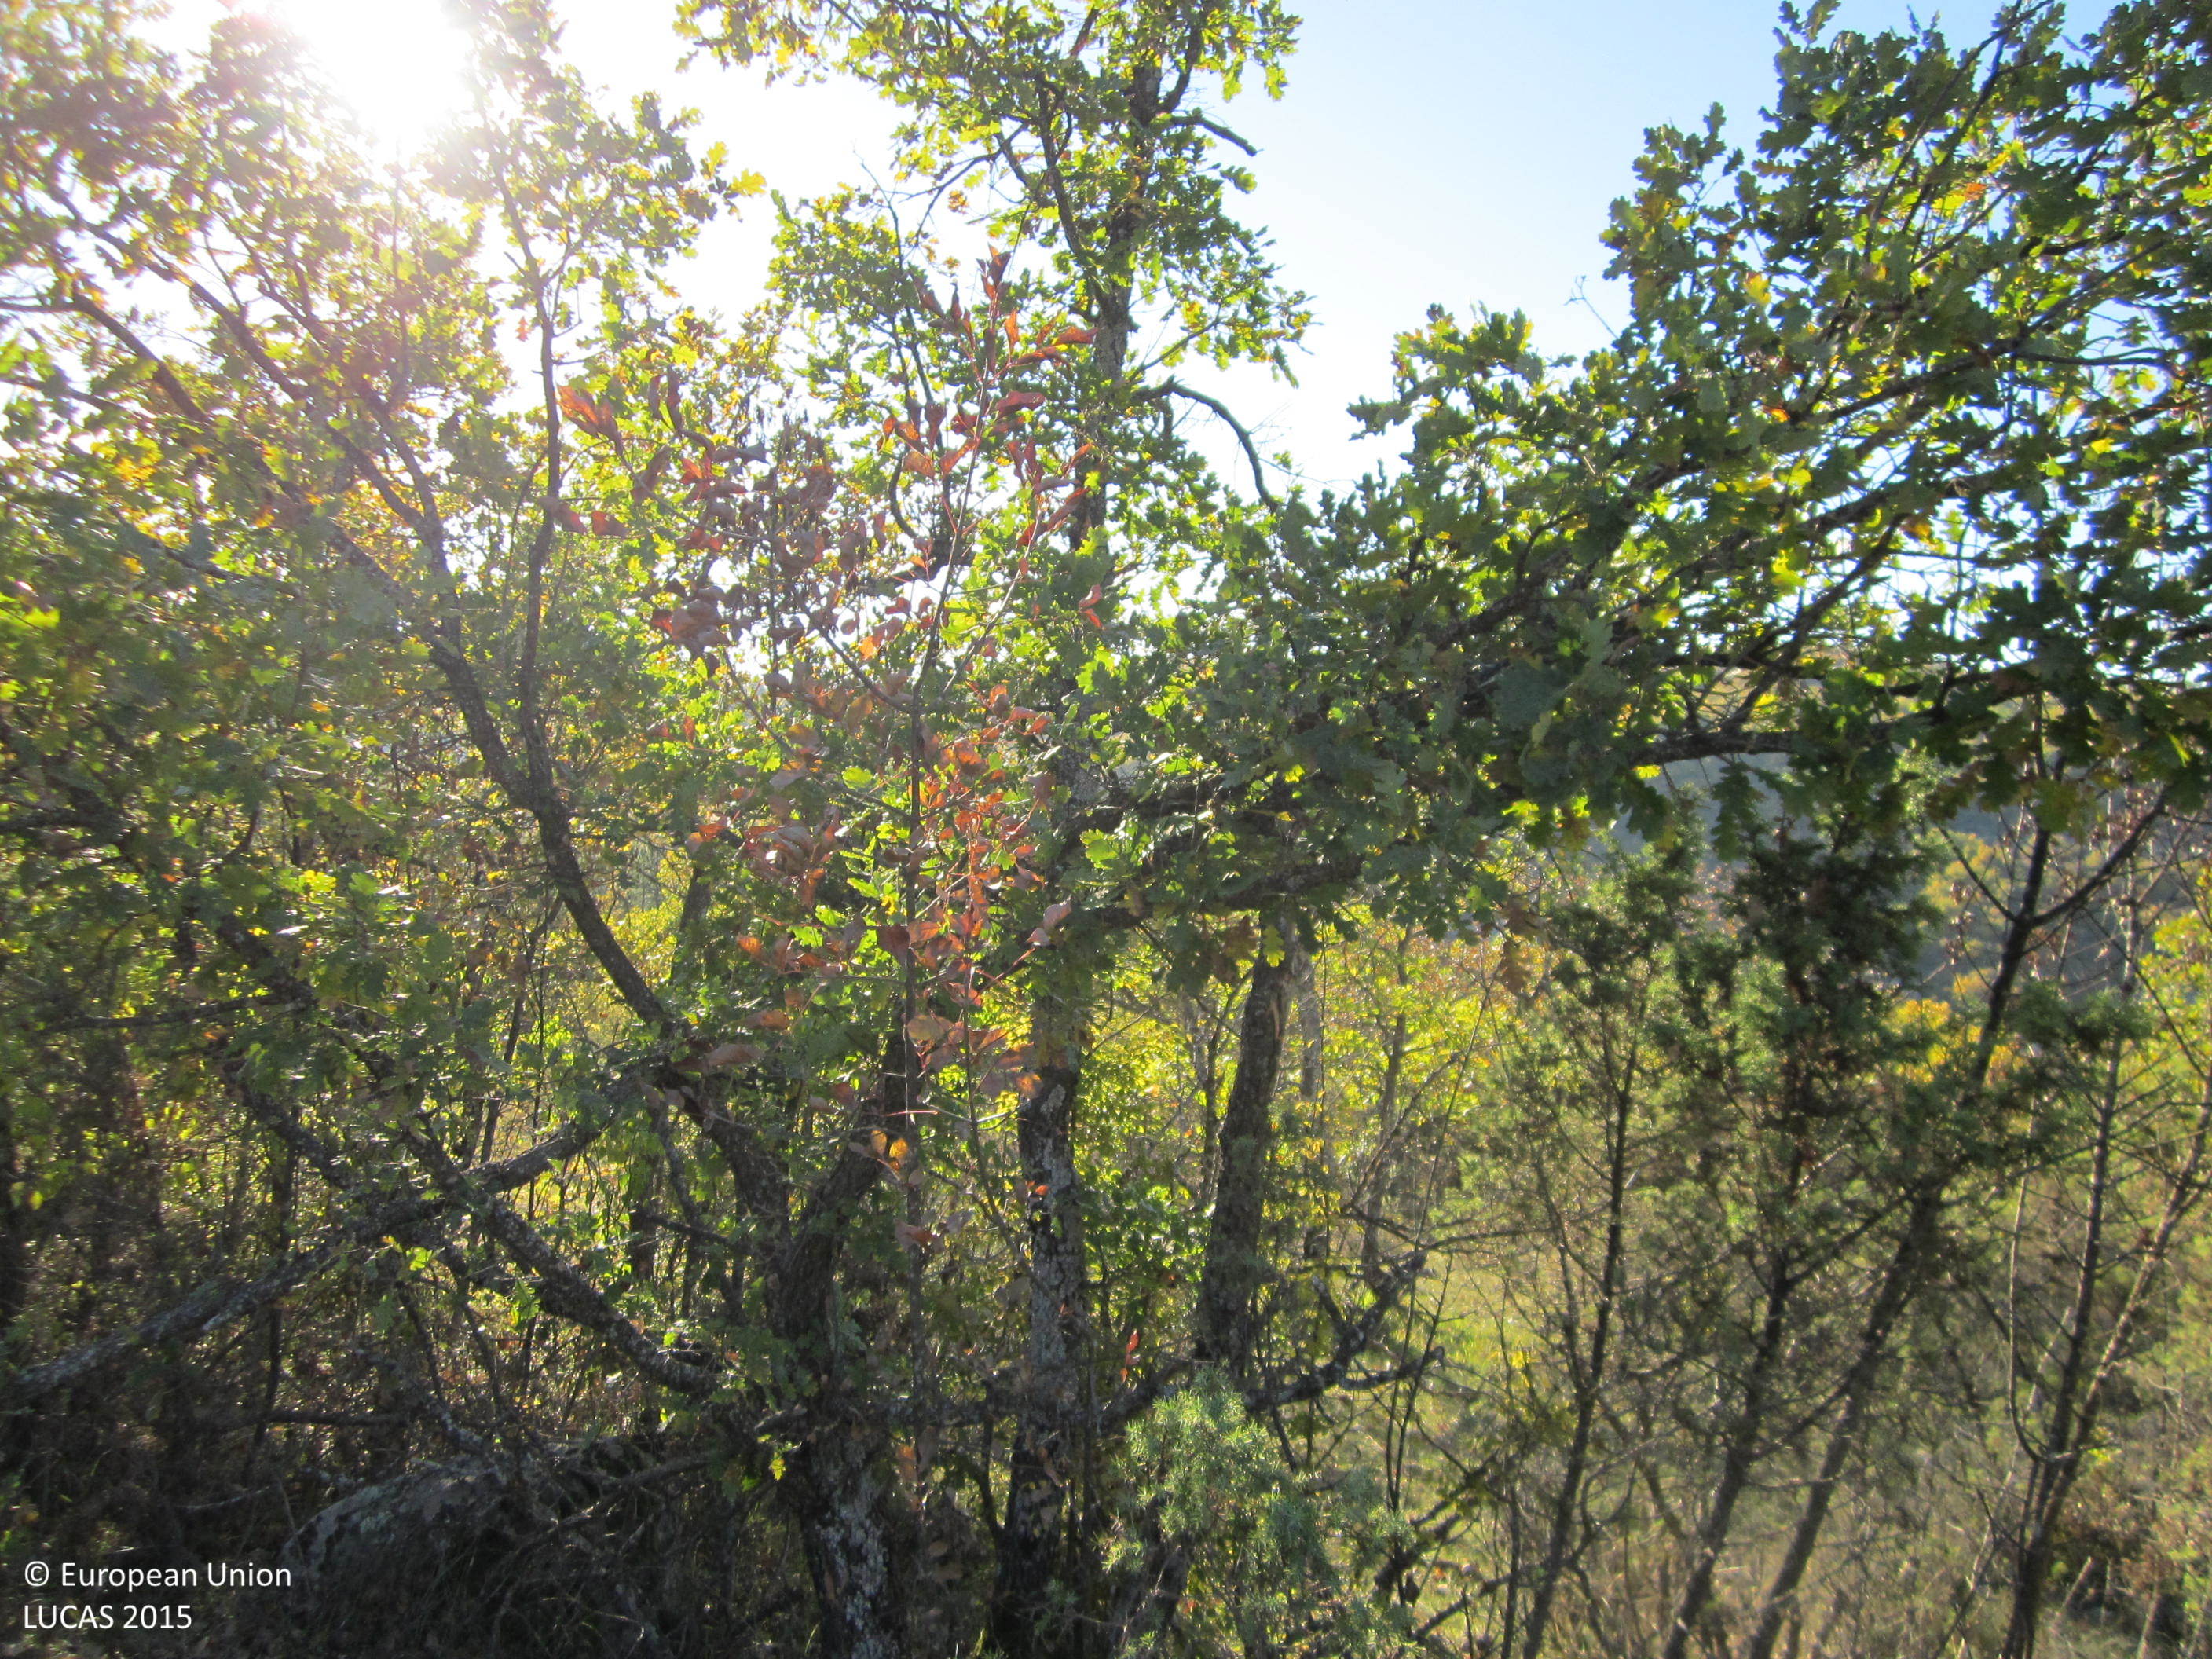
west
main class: Shrubland
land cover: Shrubland with sparse tree cover
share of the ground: 50 - 75 %
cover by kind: shrubs 55 %, herbaceous plants 35 %, broadleaved forest trees 5 %, unconsolidated bare surface 5 %
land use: Agriculture (excluding fallow land and kitchen gardens)
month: November
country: BG
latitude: 41.6011
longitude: 25.7209
